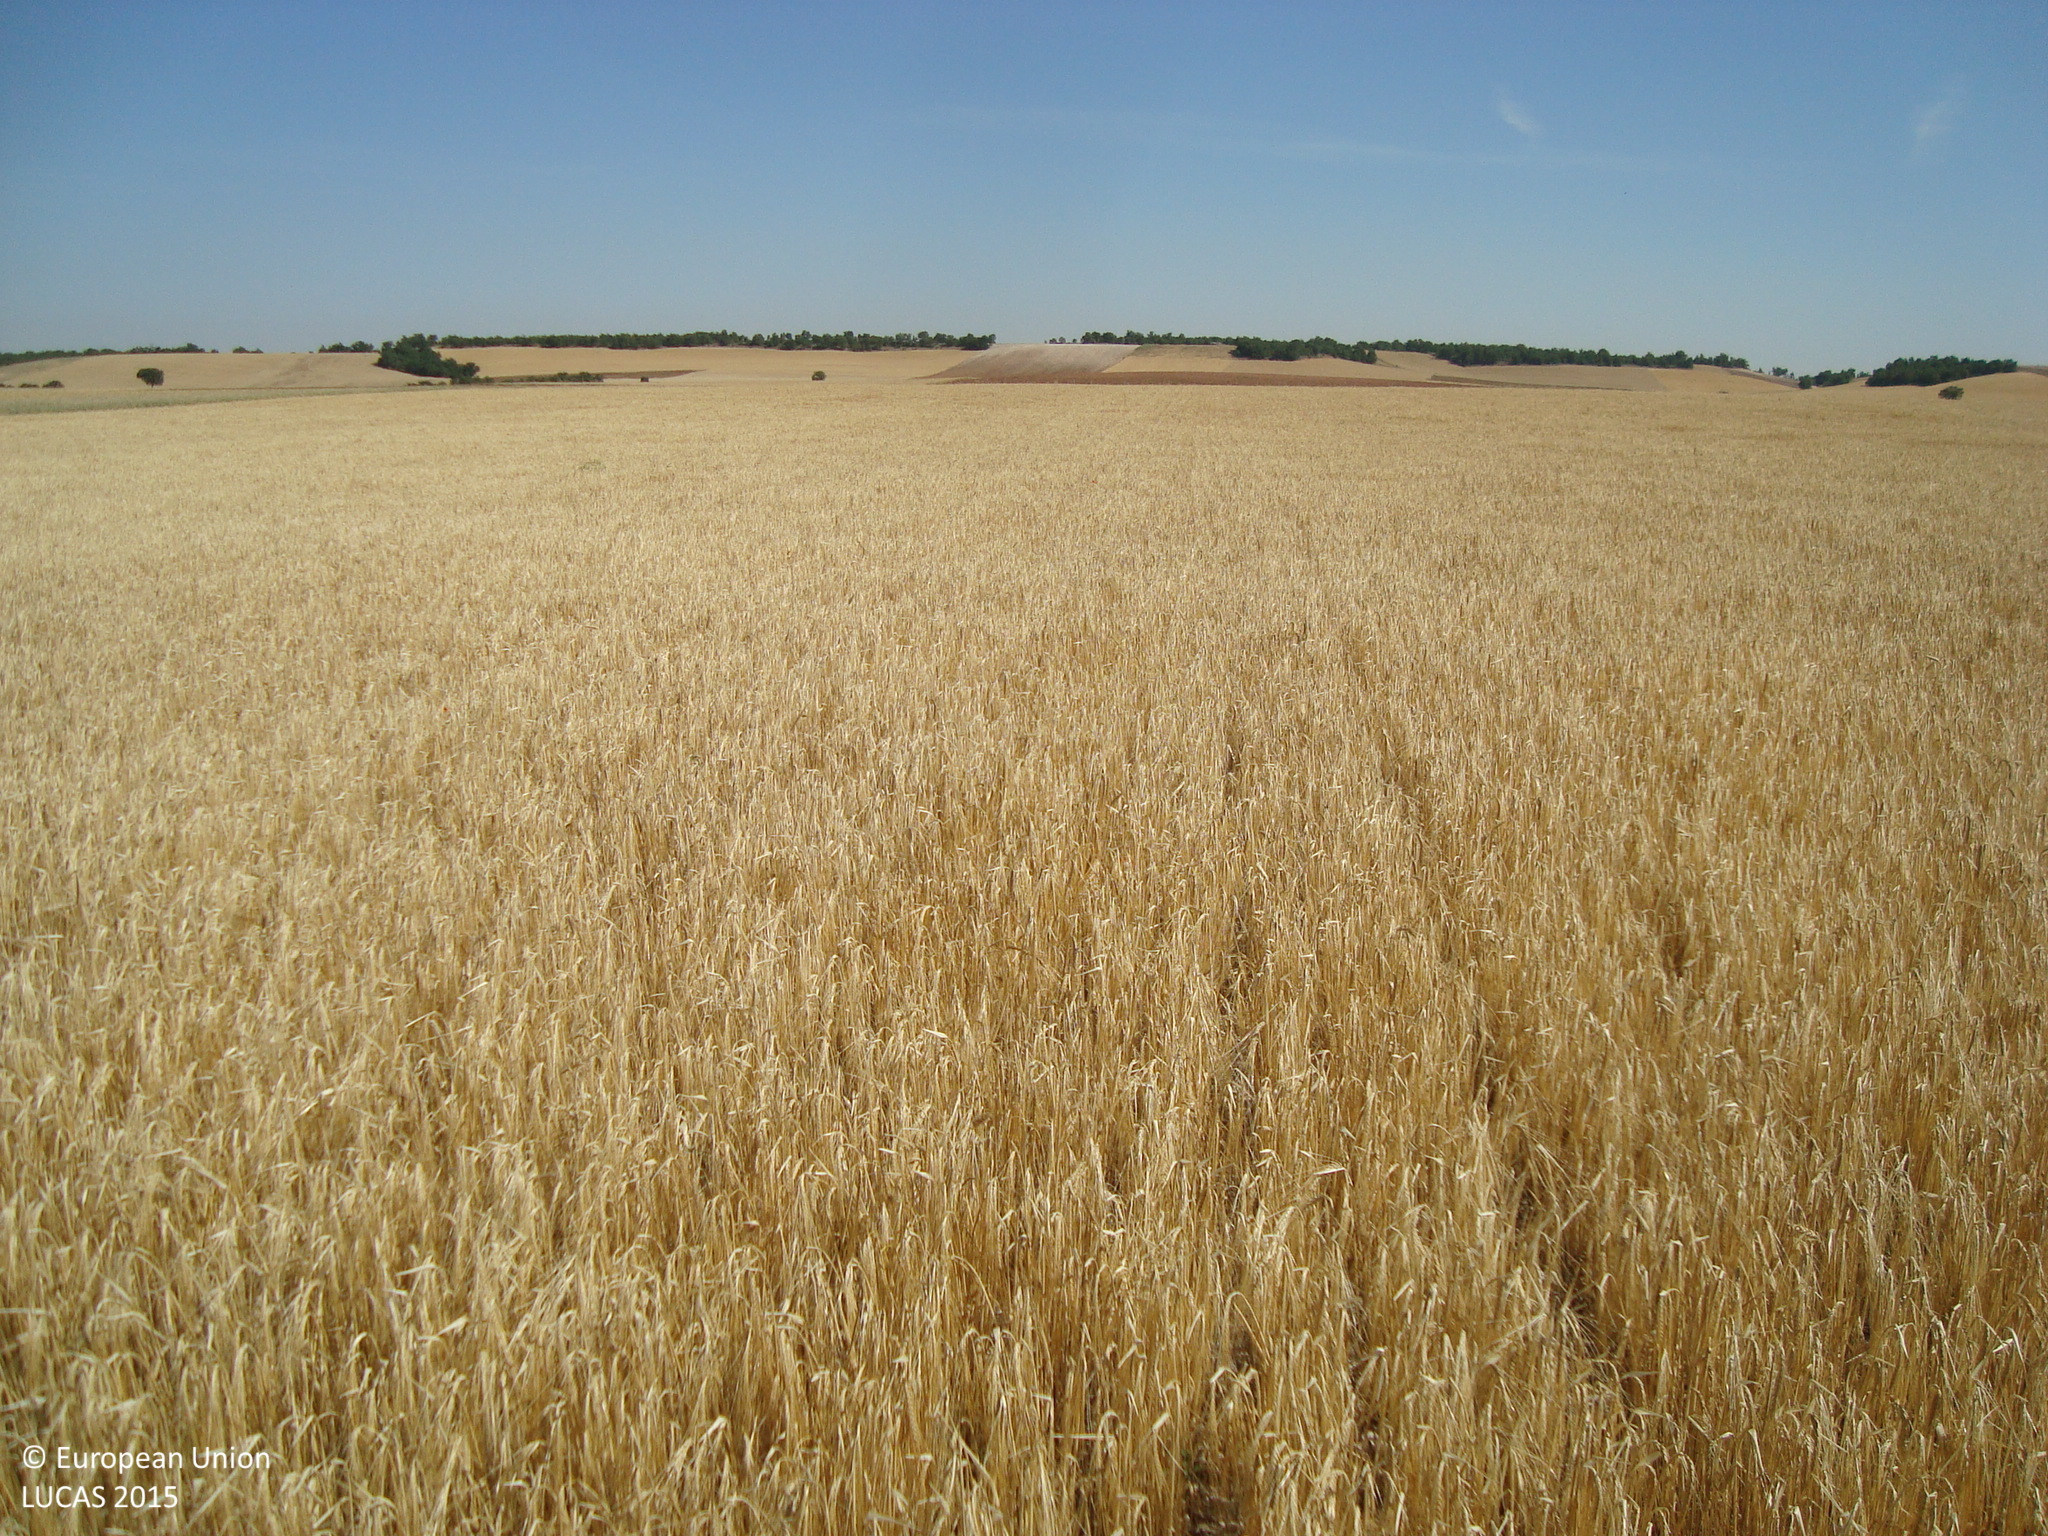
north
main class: Cropland
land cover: Barley
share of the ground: > 75 %
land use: Agriculture (excluding fallow land and kitchen gardens)
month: June
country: ES
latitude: 41.7877
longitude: -3.8584
